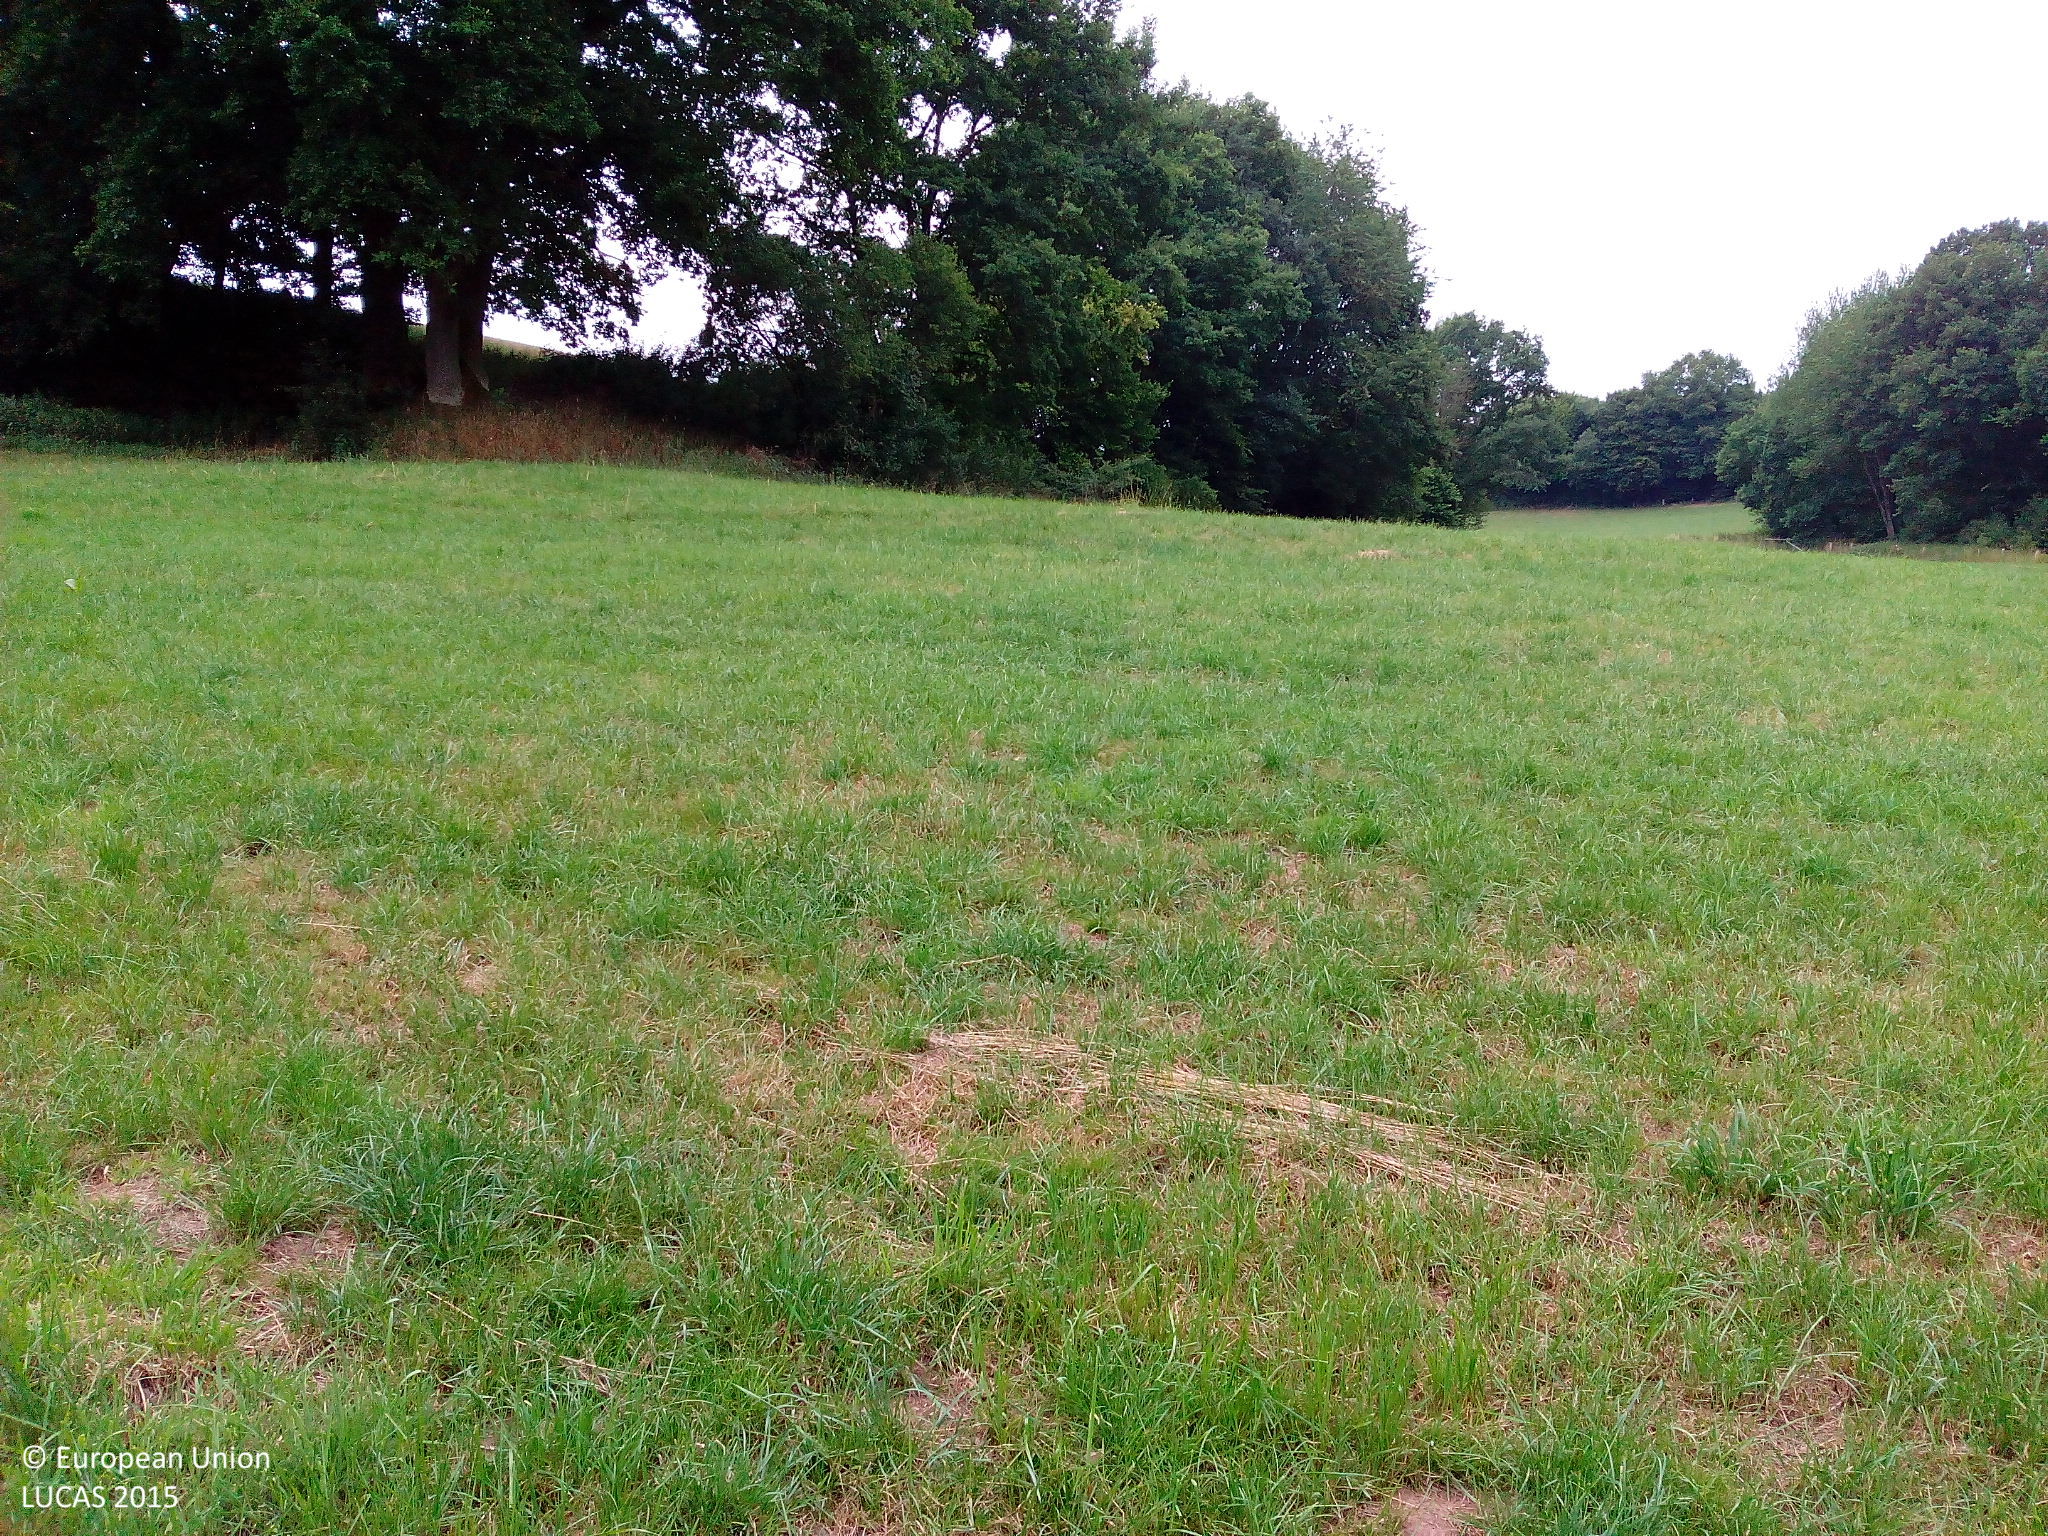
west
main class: Grassland
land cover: Grassland without tree/shrub cover
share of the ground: > 75 %
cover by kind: herbaceous plants 100 %
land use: Agriculture (excluding fallow land and kitchen gardens)
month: July
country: DE
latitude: 50.8315
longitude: 9.9290
